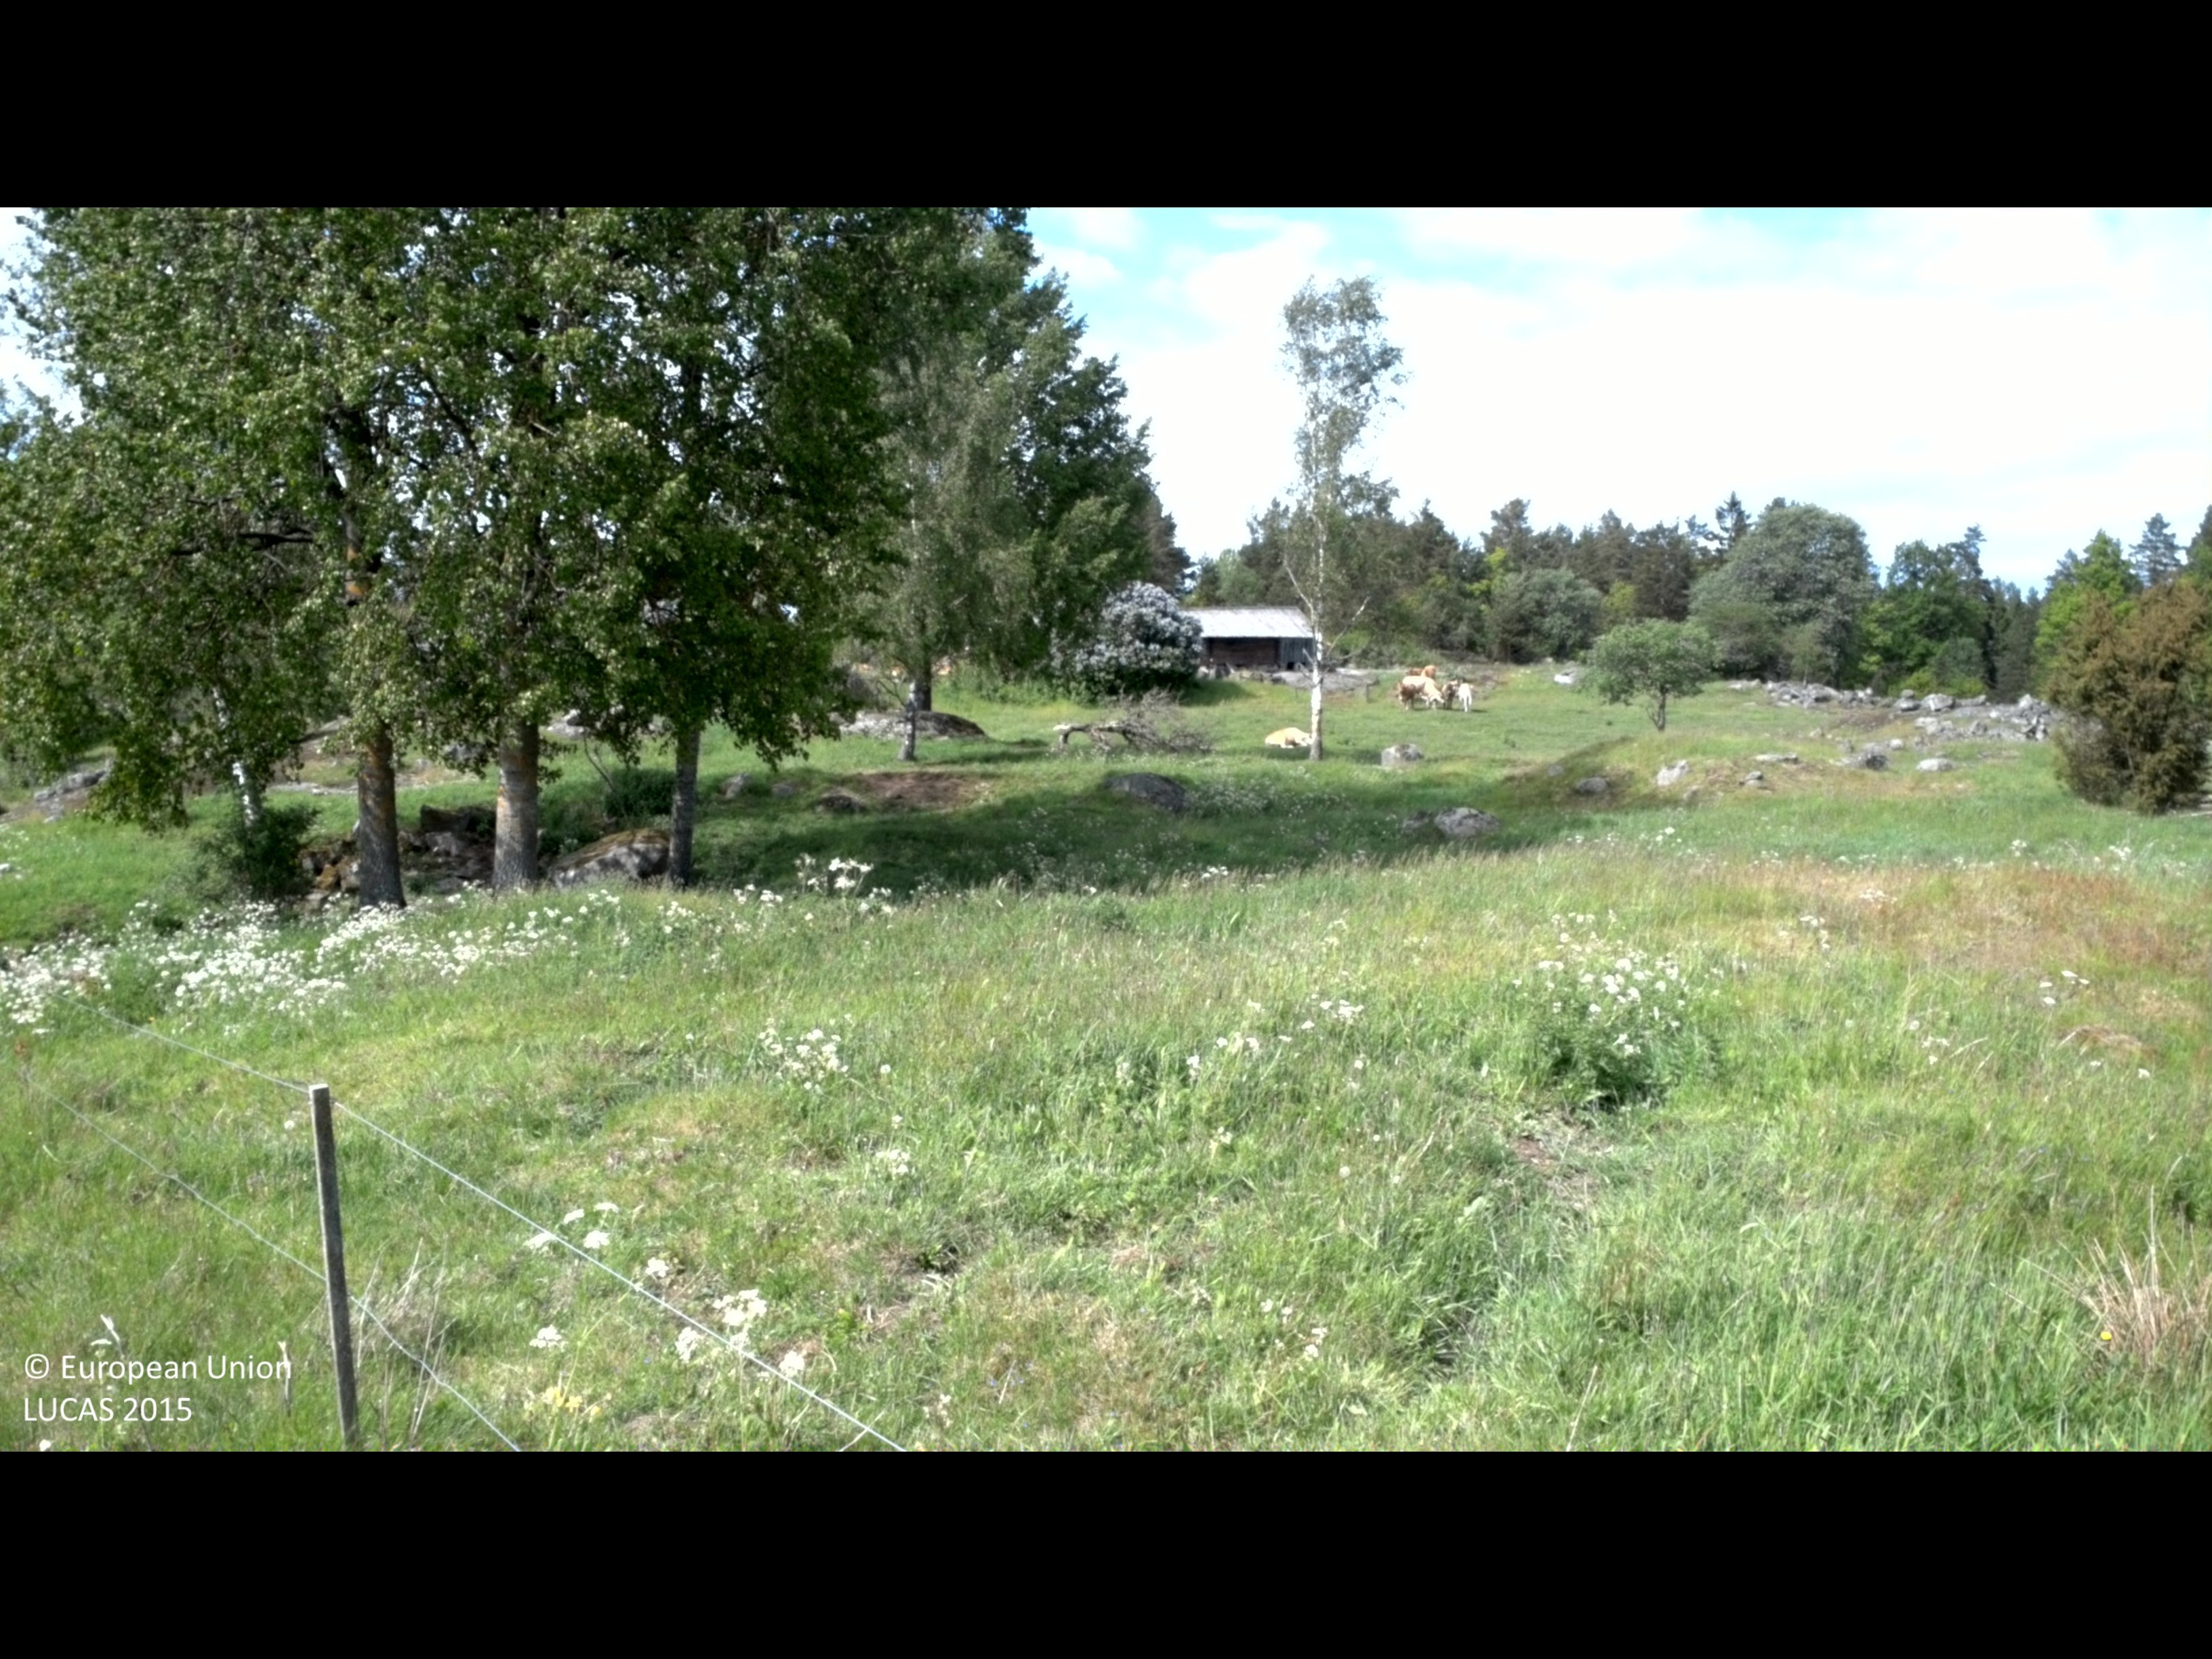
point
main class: Grassland
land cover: Grassland with sparse tree/shrub cover
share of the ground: > 75 %
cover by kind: herbaceous plants 90 %, broadleaved forest trees 5 %, shrubs 5 %
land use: Agriculture (excluding fallow land and kitchen gardens)
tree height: > 5 m
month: May
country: SE
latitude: 57.5389
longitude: 16.4973
